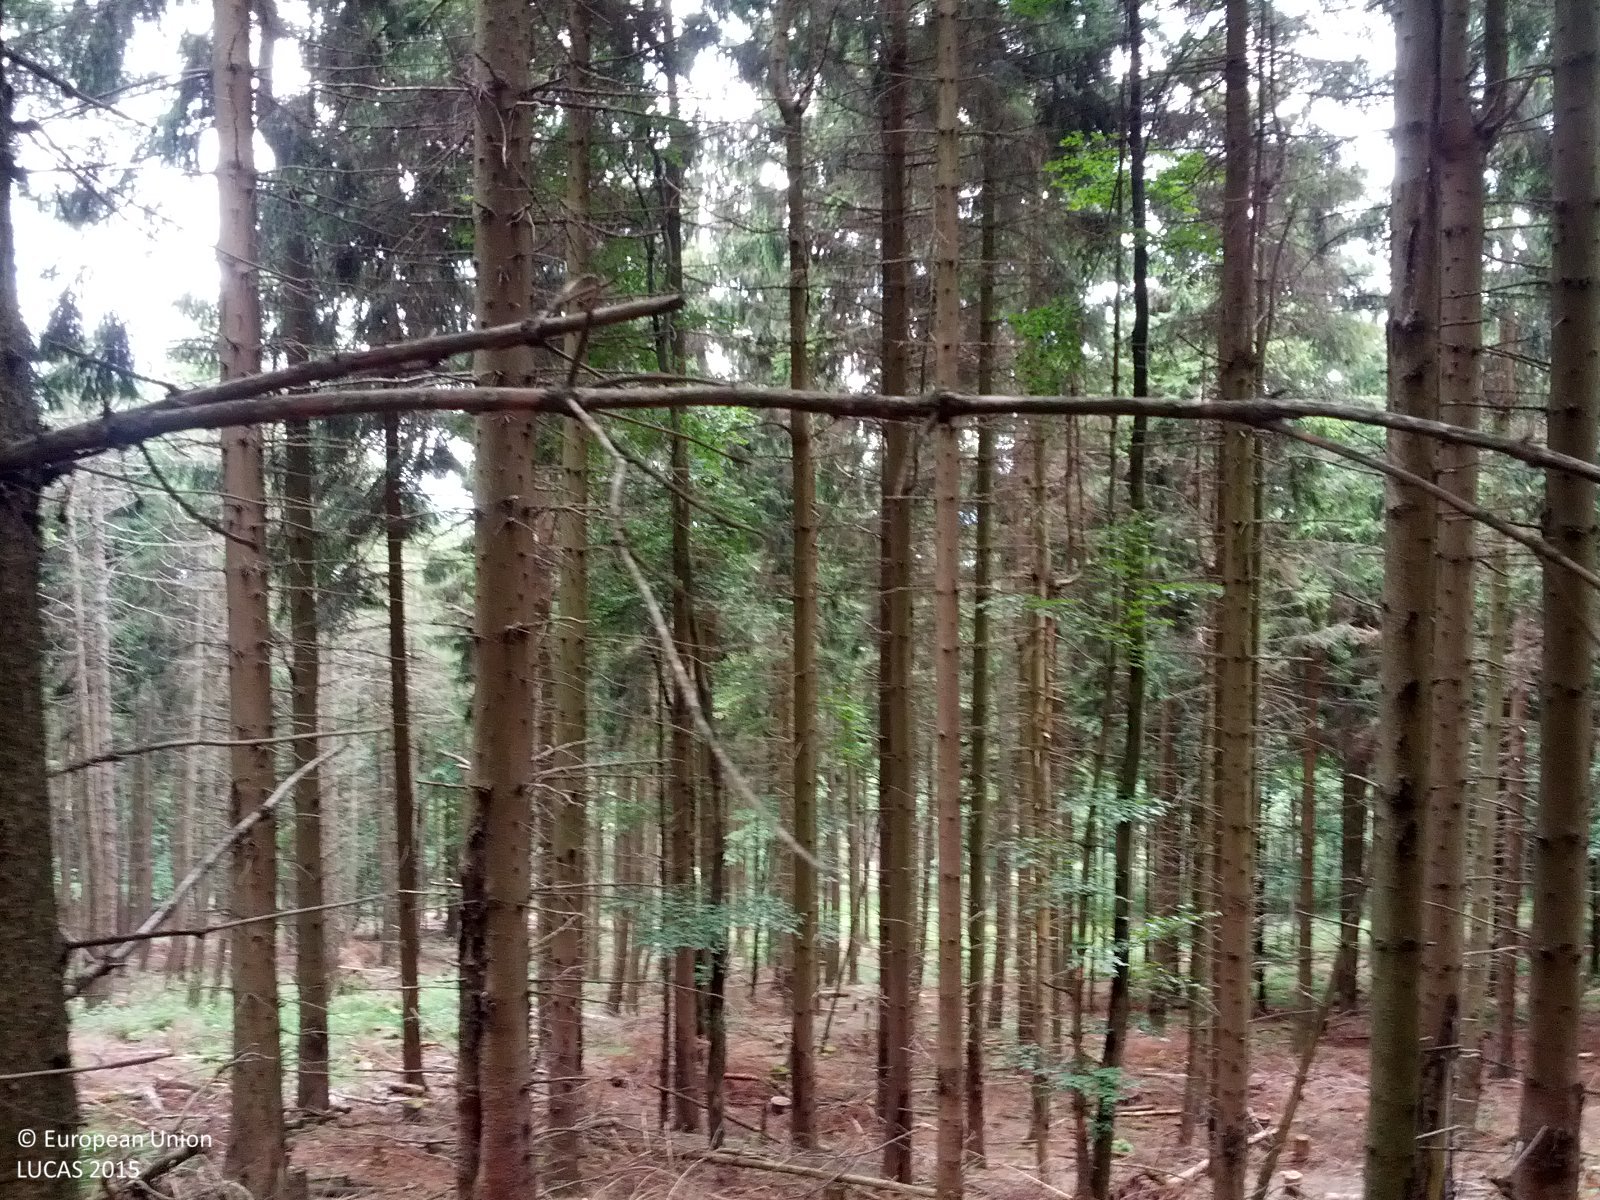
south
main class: Woodland
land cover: Spruce dominated coniferous woodland
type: alpine coniferous forest
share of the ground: > 75 %
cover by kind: coniferous forest trees 90 %, shrubs 5 %, unconsolidated bare surface 5 %
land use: Forestry
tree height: > 5 m
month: July
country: AT
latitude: 47.3501
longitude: 16.4234
